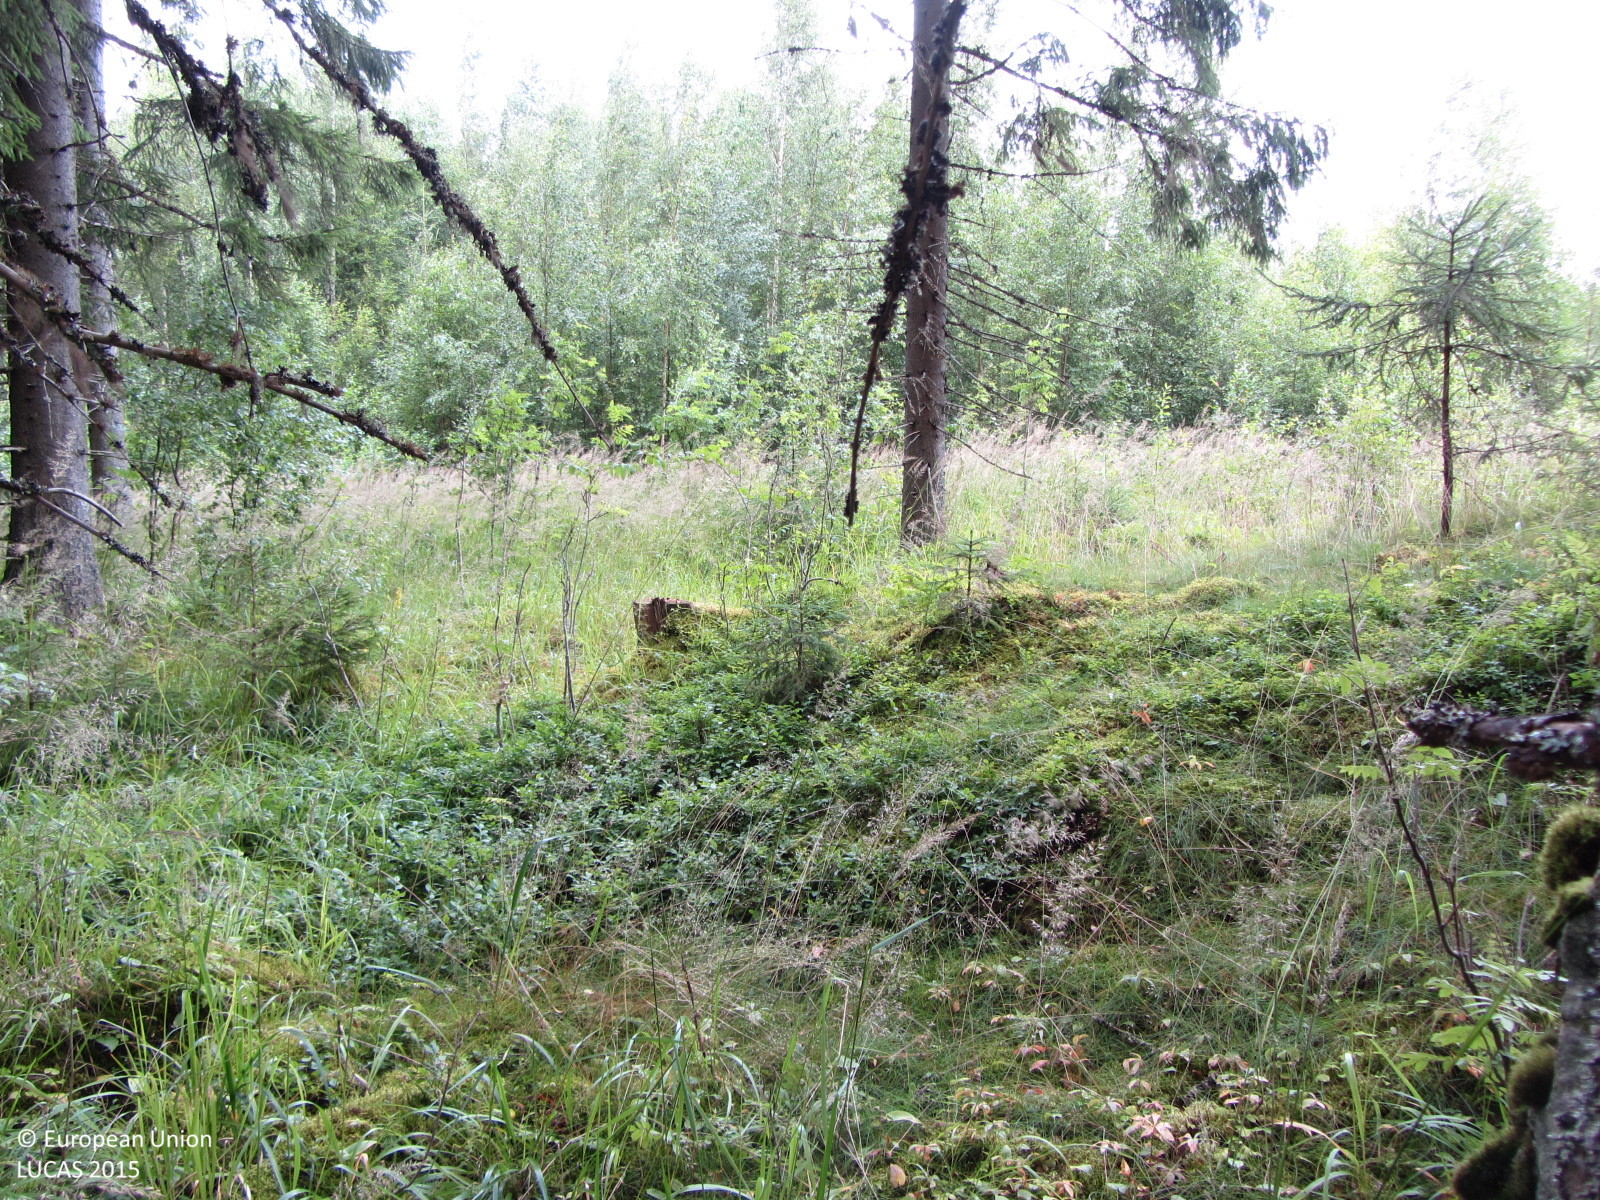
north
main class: Woodland
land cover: Spruce dominated coniferous woodland
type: boreal forest
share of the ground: > 75 %
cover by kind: coniferous forest trees 80 %, herbaceous plants 15 %, broadleaved forest trees 5 %
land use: Forestry
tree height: > 5 m
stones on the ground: 10 - 25 %
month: August
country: FI
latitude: 60.6932
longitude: 24.6686
